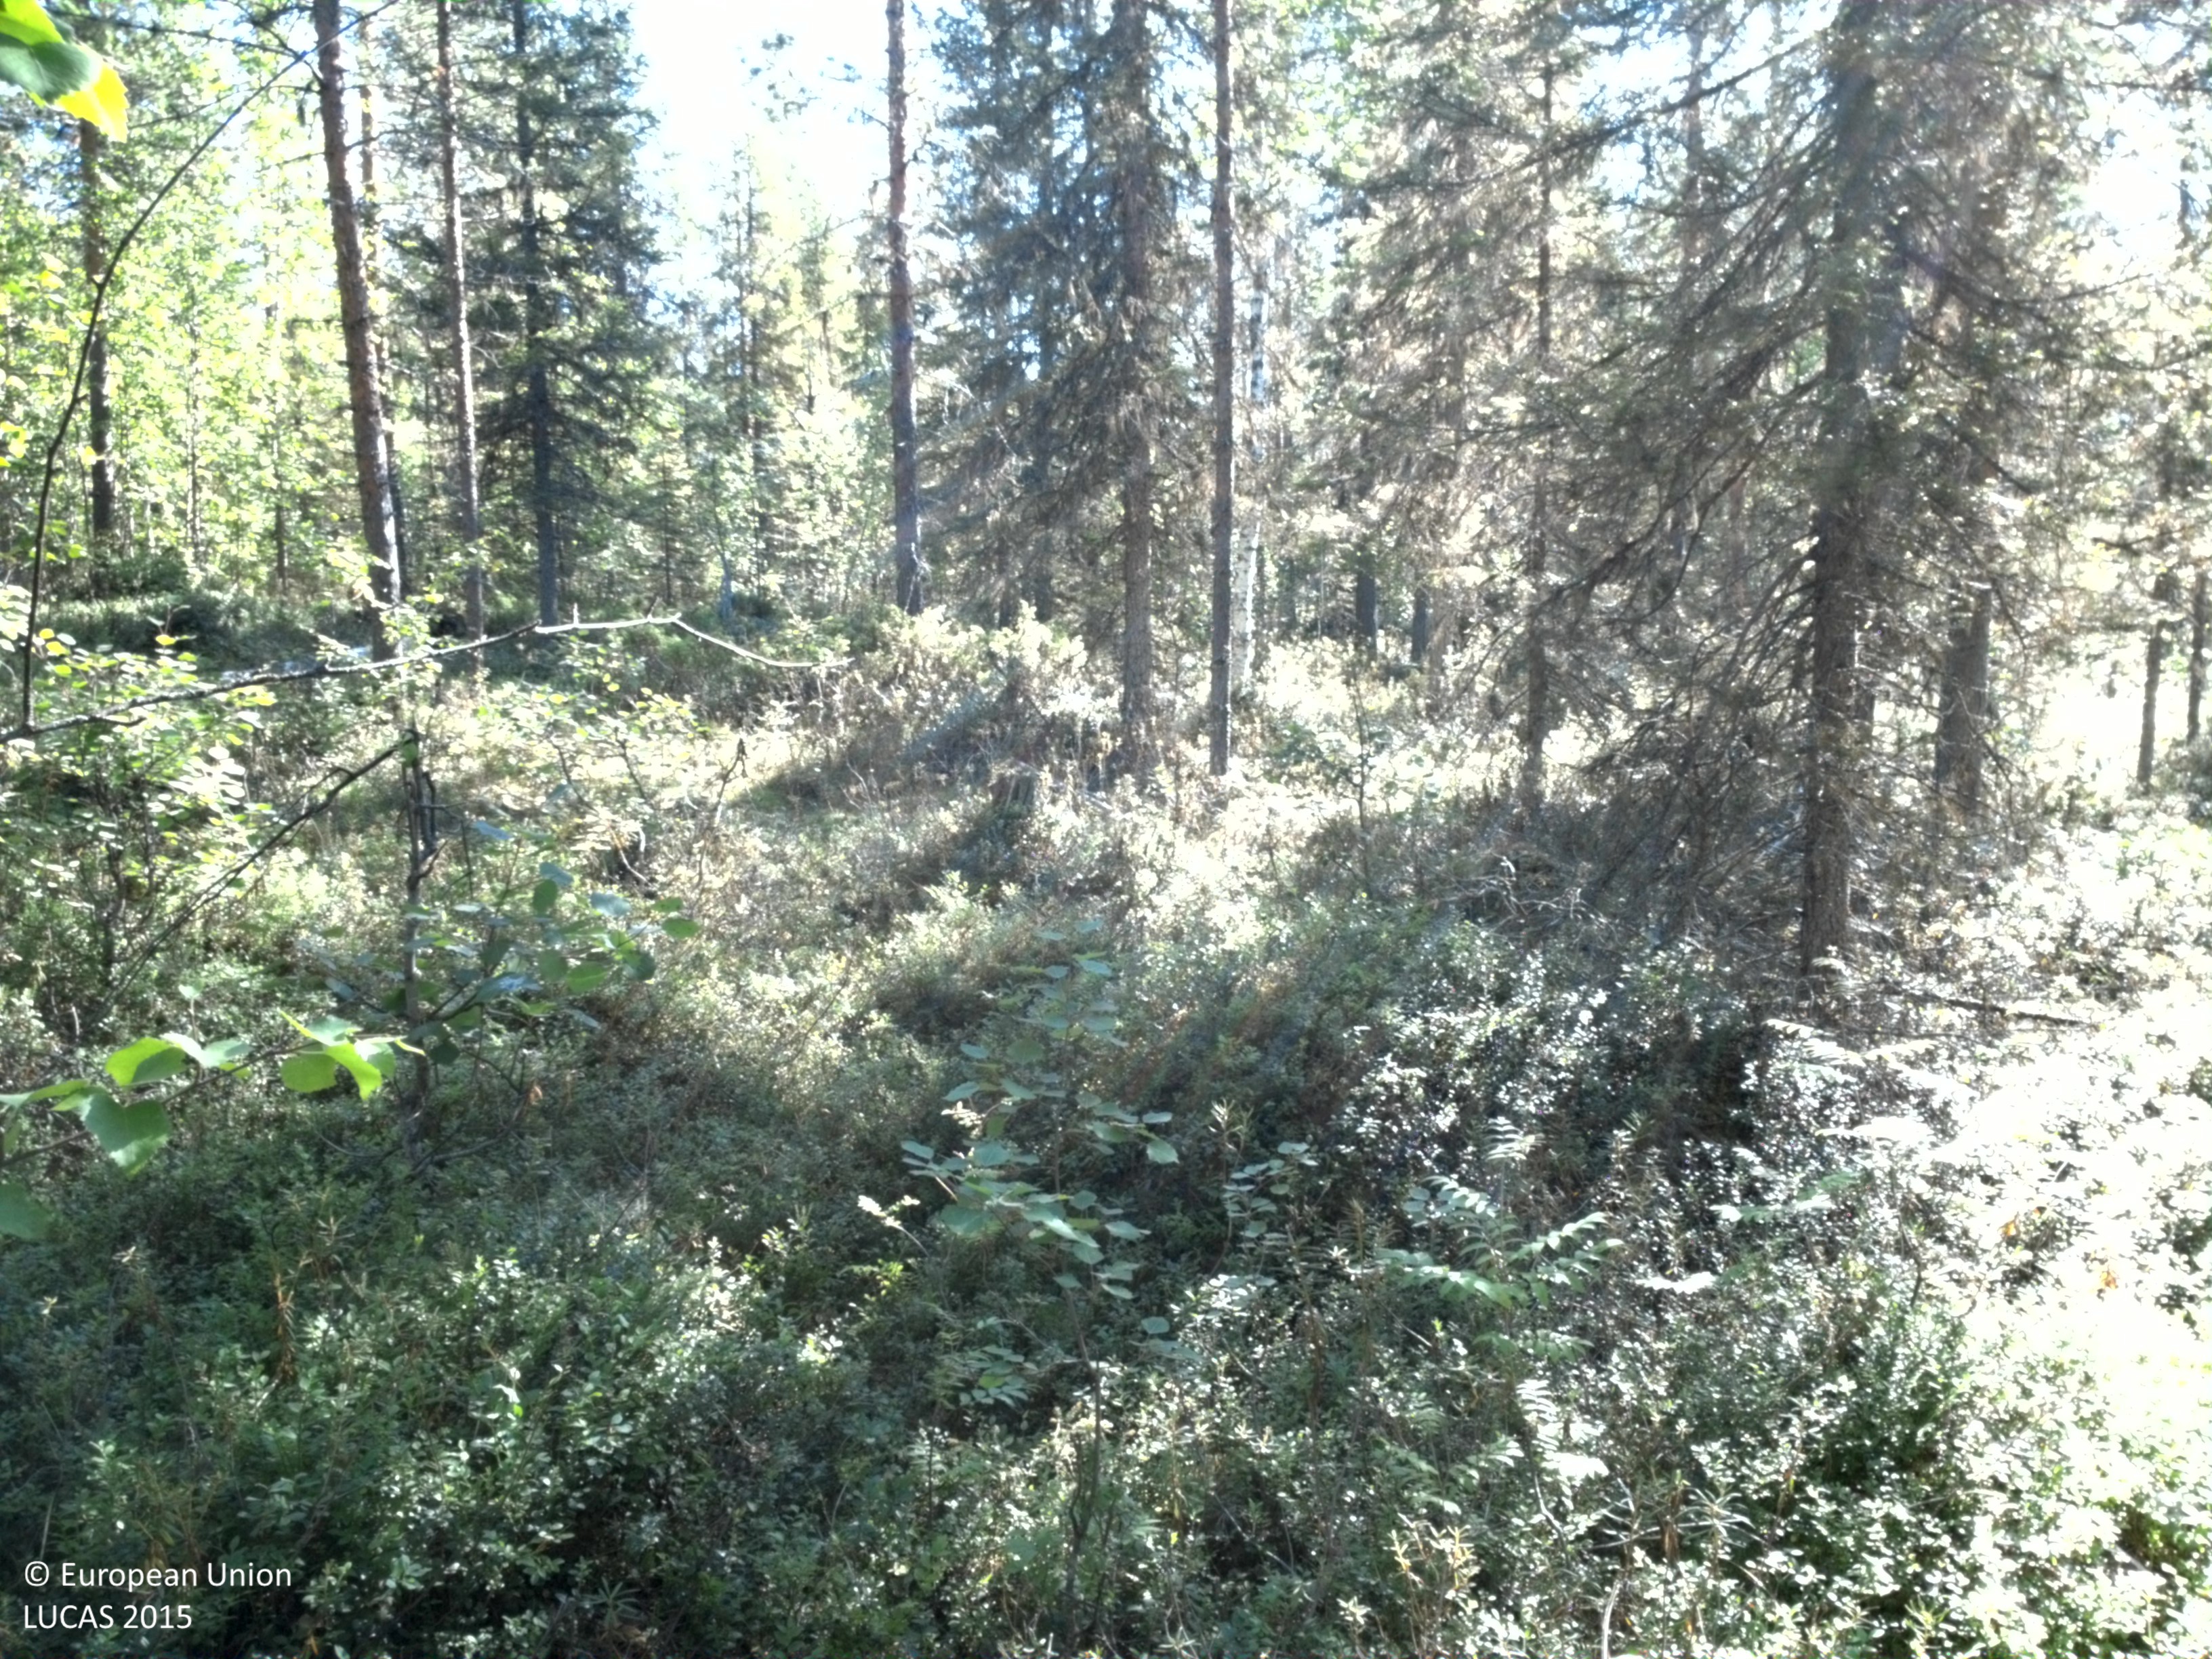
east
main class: Woodland
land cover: Pine dominated coniferous woodland
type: boreal forest
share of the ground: 25 - 50 %
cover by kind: shrubs 60 %, coniferous forest trees 35 %, broadleaved forest trees 5 %
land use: Forestry
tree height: > 5 m
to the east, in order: Pine dominated coniferous woodland; Broadleaved woodland; Shrubland without tree cover; Tracks; Shrubland with sparse tree cover; Ditches and canals; Broadleaved woodland; Spruce dominated mixed woodland; Broadleaved woodland; Tracks; Shrubland with sparse tree cover; Spruce dominated coniferous woodland
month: August
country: SE
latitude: 66.2342
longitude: 20.6114
